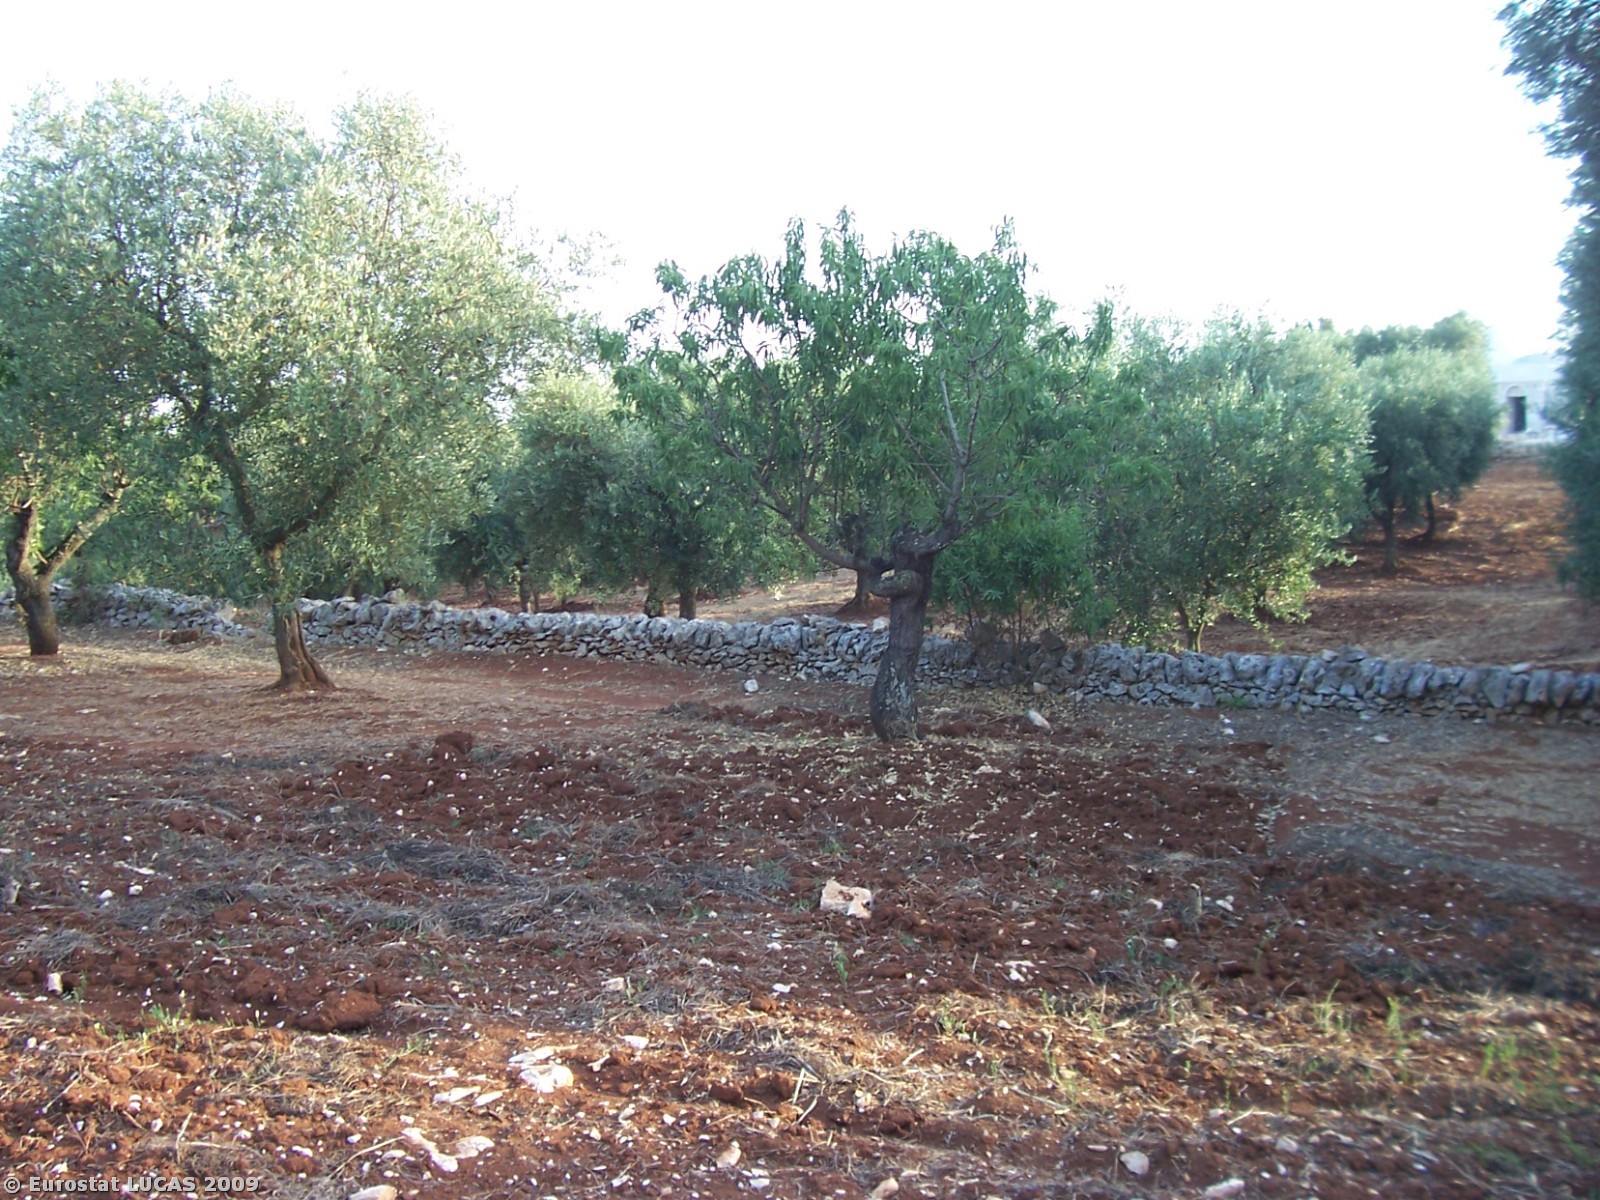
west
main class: Cropland
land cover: Olive groves
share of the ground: 50 - 75 %
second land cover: Bare land
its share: > 75 %
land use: Agriculture (excluding fallow land and kitchen gardens)
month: July
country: IT
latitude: 40.6854
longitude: 17.5379
